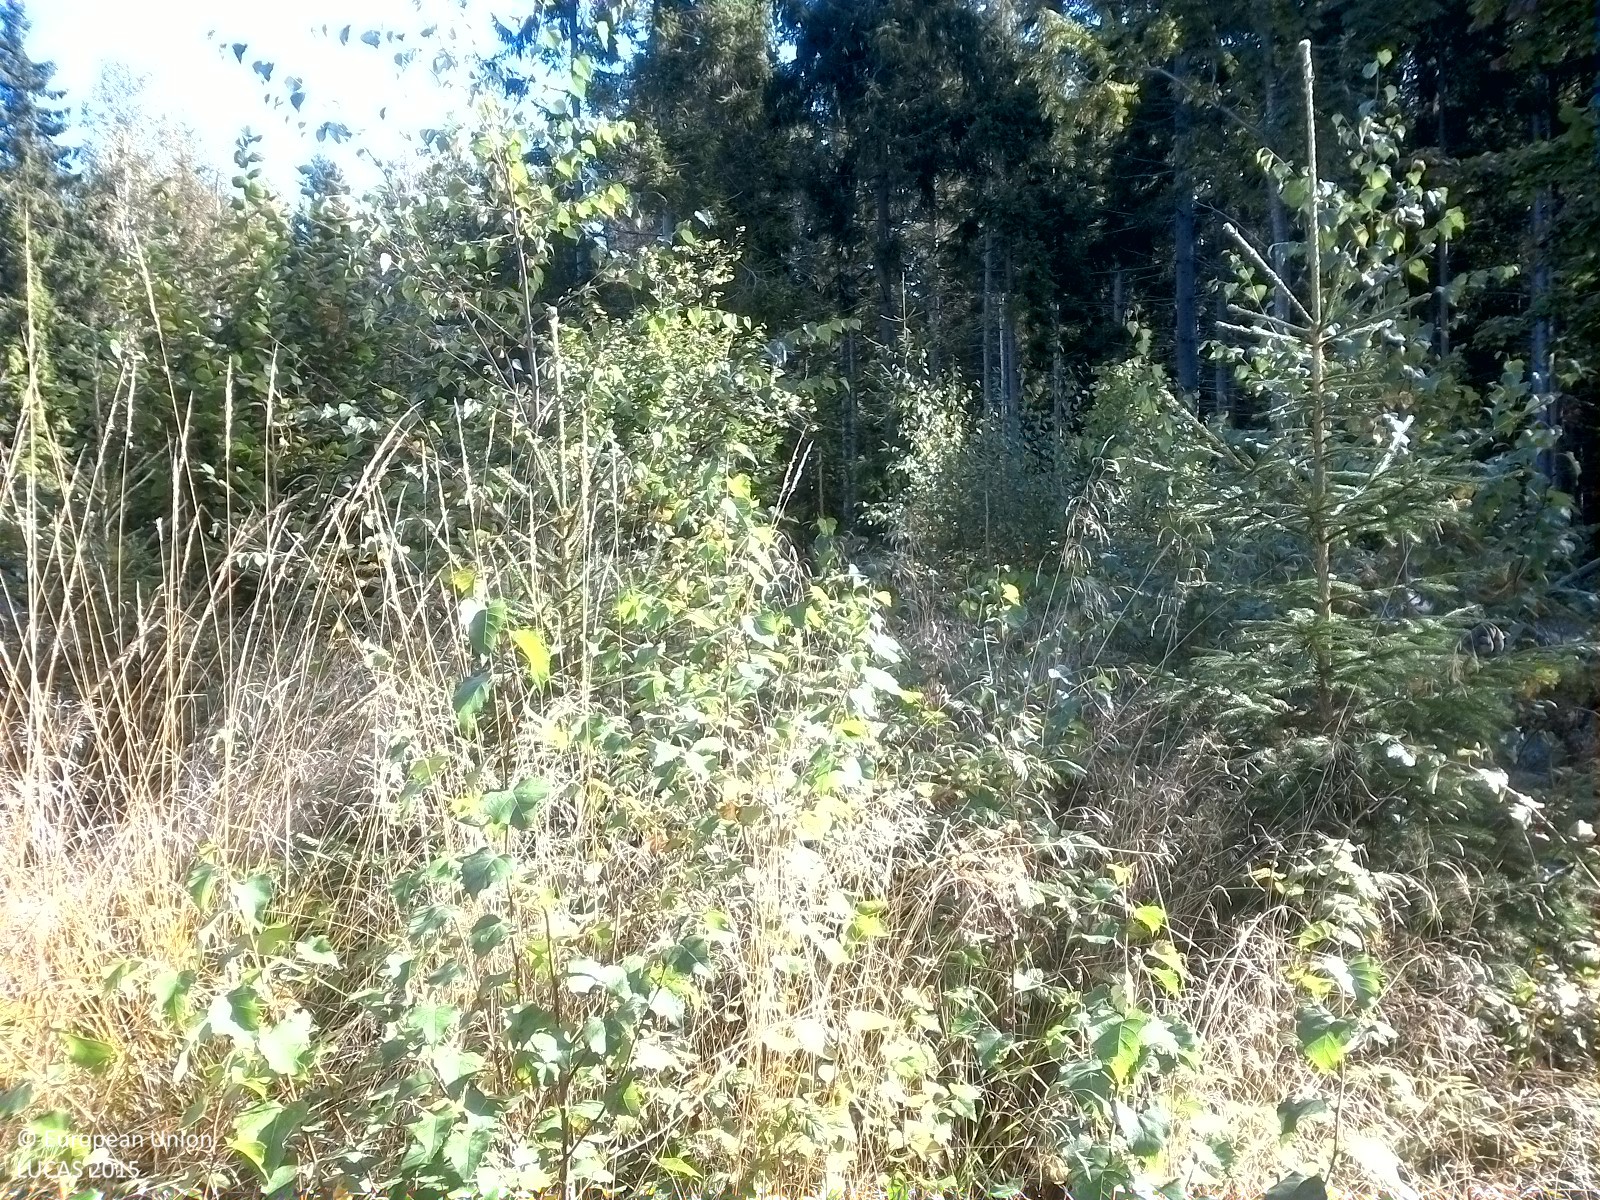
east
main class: Woodland
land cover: Spruce dominated mixed woodland
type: boreal forest
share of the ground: 25 - 50 %
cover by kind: herbaceous plants 40 %, coniferous forest trees 20 %, broadleaved forest trees 20 %, shrubs 10 %, lichens and mosses 10 %
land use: Forestry
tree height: < 5 m
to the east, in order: Spruce dominated mixed woodland; Spruce dominated coniferous woodland; Ditches and canals; Spruce dominated coniferous woodland; Ditches and canals; Spruce dominated mixed woodland; Broadleaved woodland
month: September
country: SE
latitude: 59.0371
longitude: 15.6912
